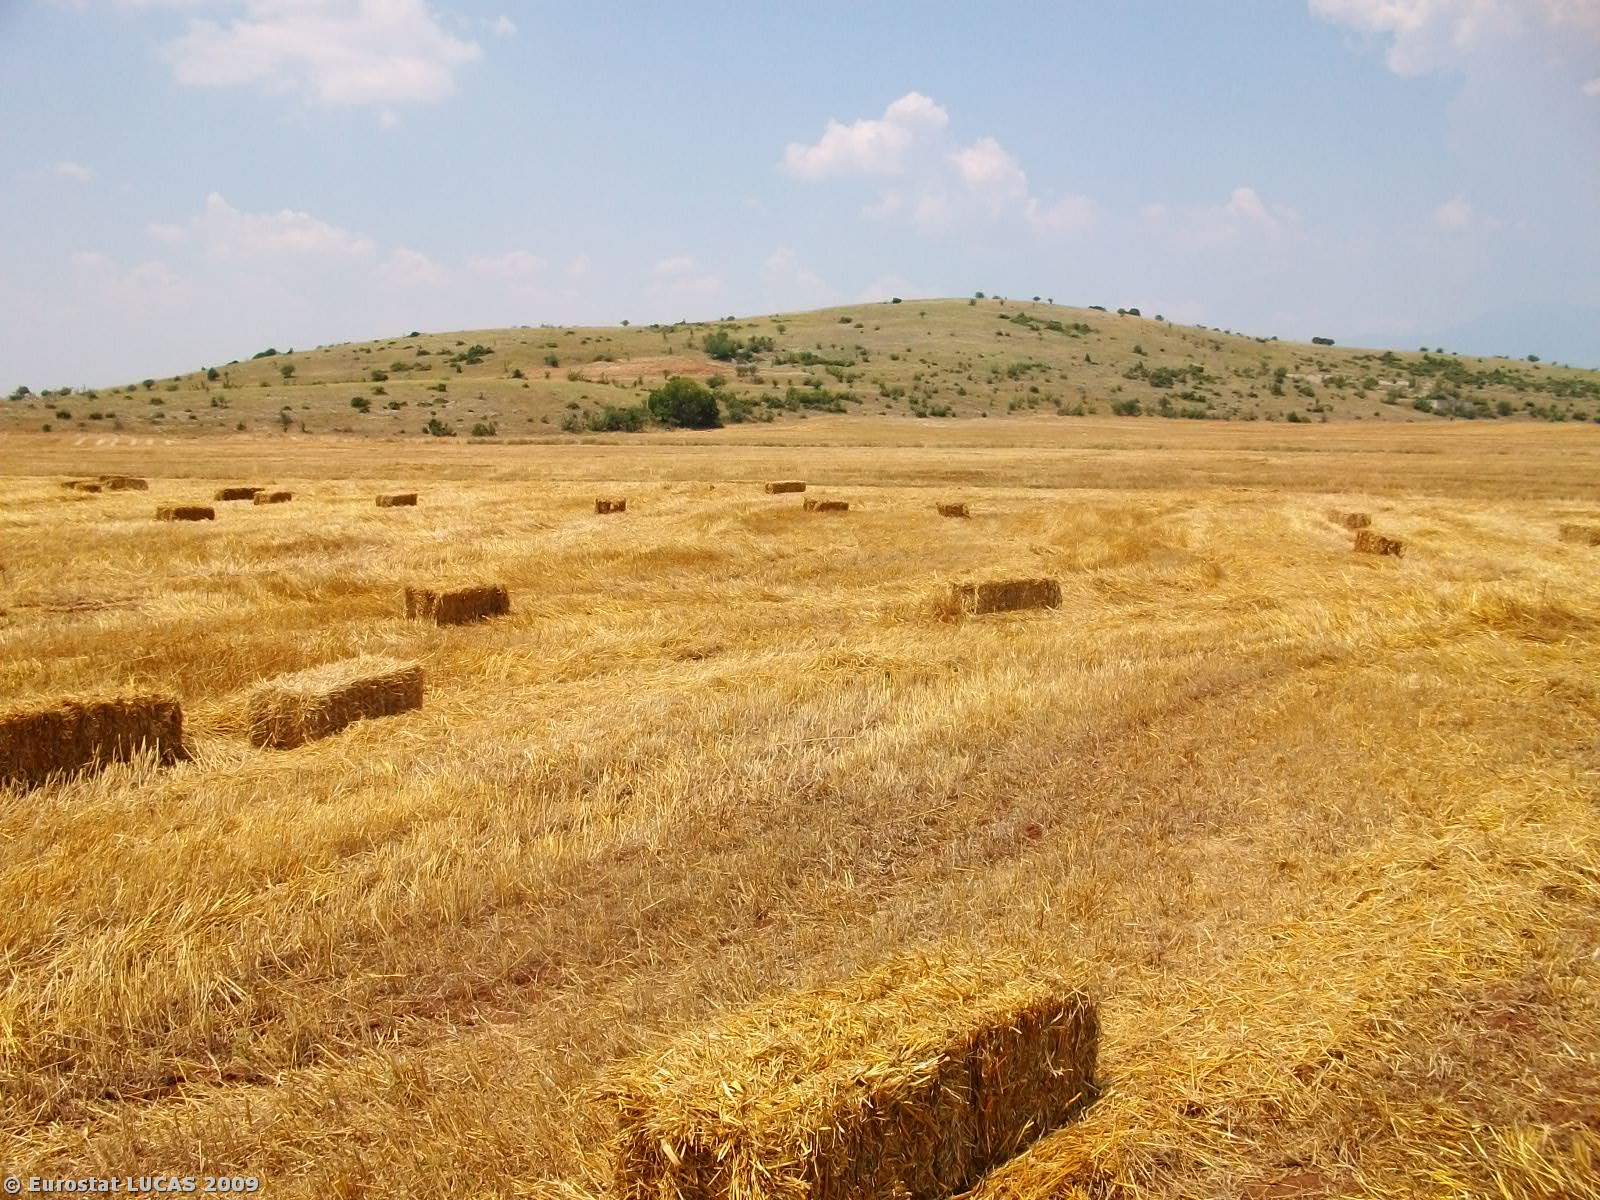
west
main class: Cropland
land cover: Durum wheat
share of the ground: < 10 %
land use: Agriculture (excluding fallow land and kitchen gardens)
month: July
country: GR
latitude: 40.6978
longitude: 21.8430
